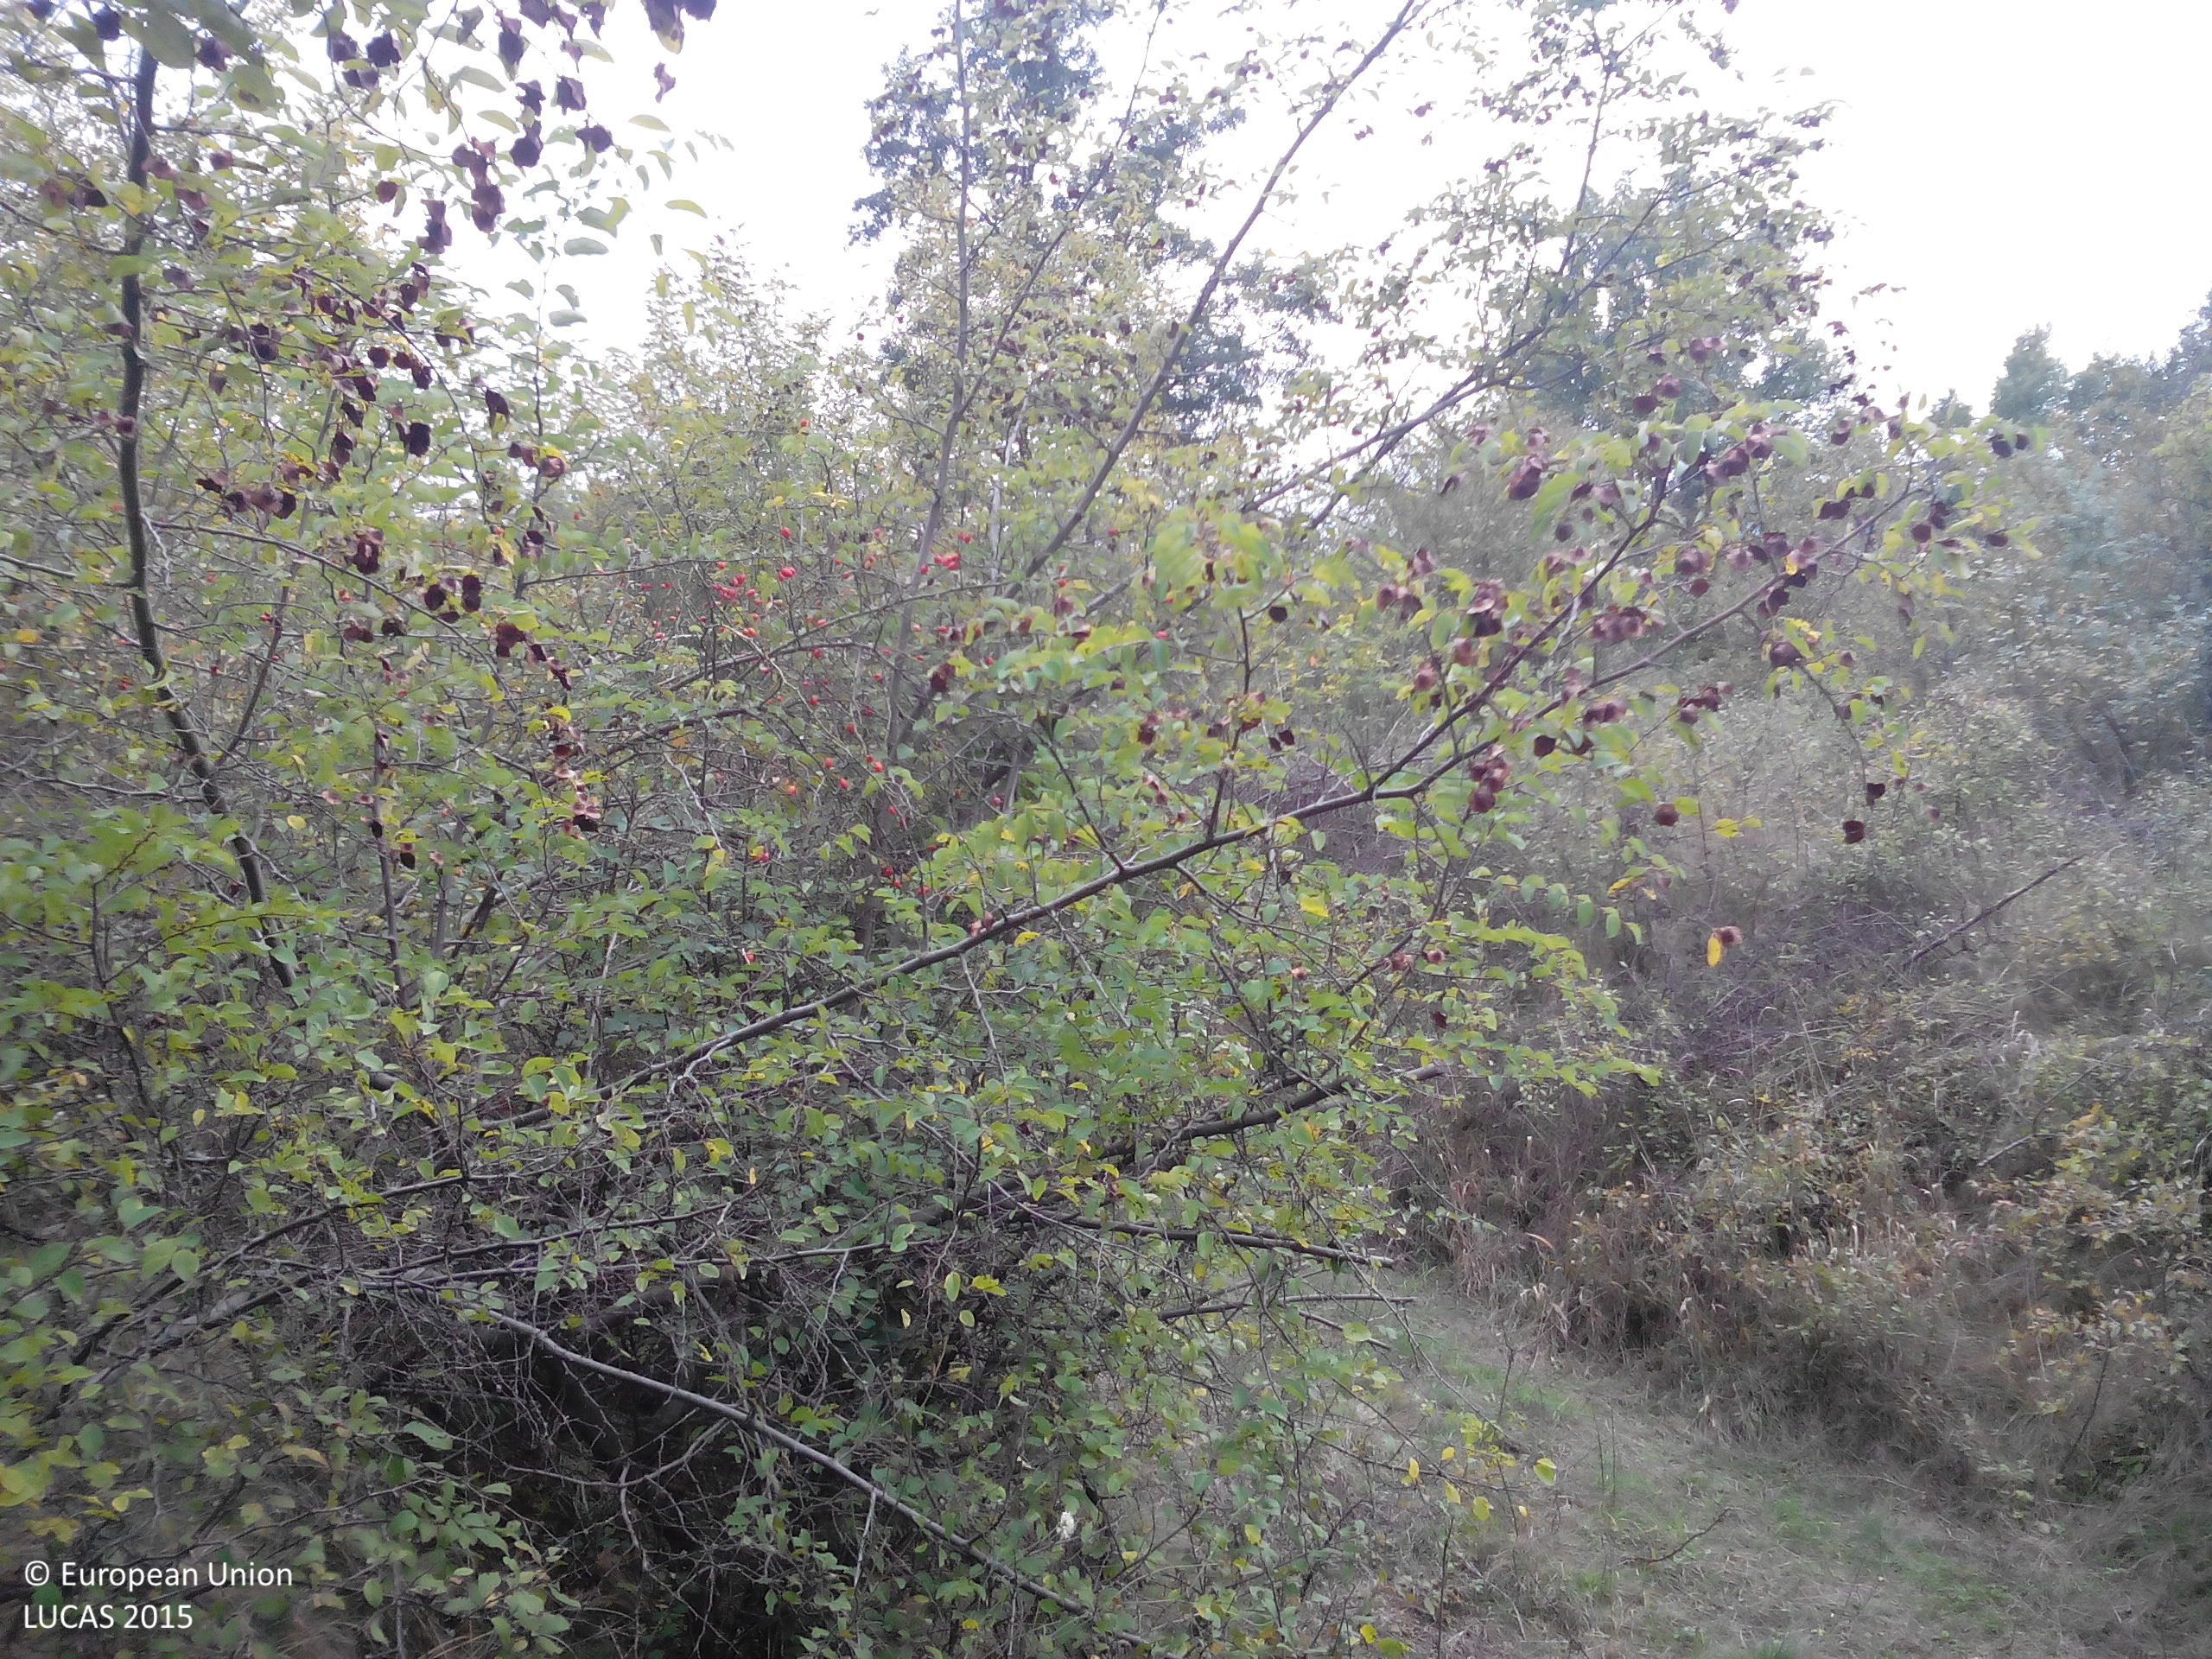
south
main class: Woodland
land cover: Broadleaved woodland
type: mesophytic deciduous forest
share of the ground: 50 - 75 %
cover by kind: broadleaved forest trees 70 %, shrubs 15 %, herbaceous plants 15 %
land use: Forestry
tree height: > 5 m
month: October
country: BG
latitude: 43.2423
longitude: 24.0536
